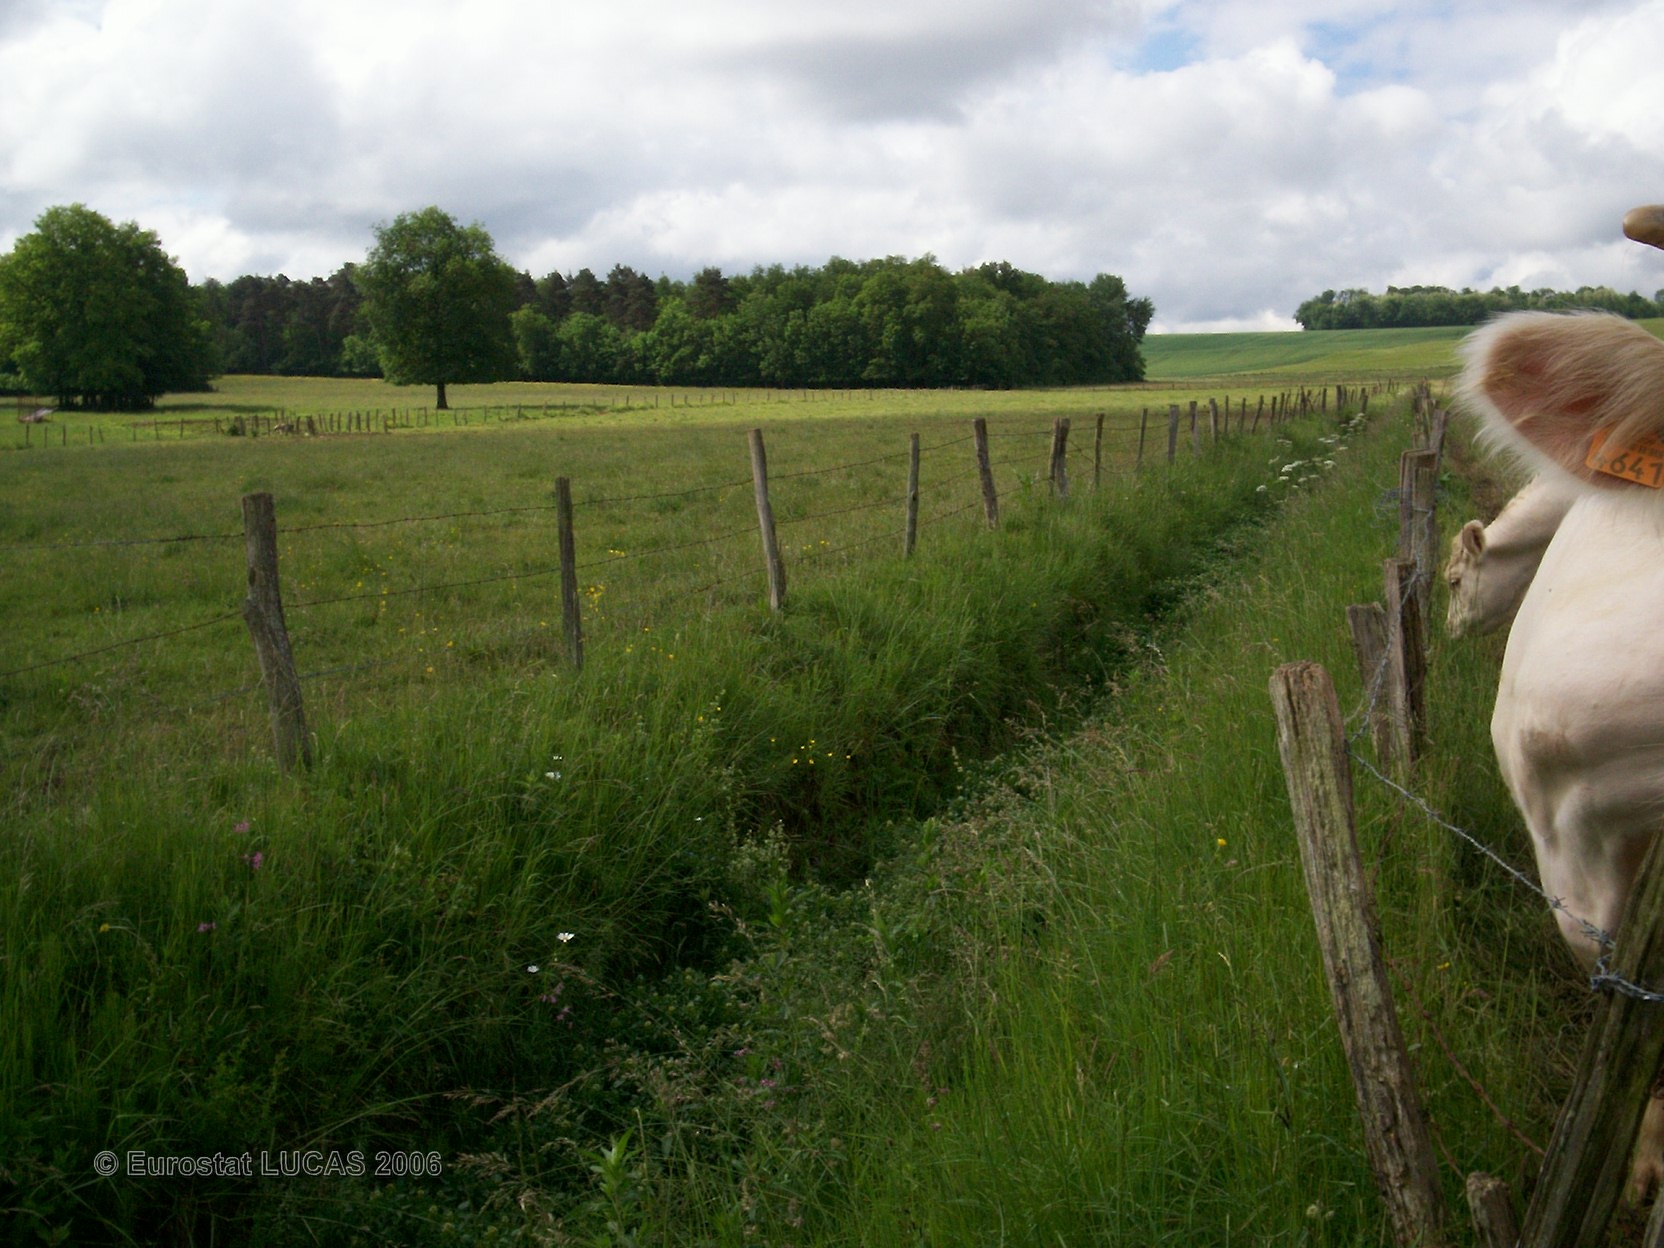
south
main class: Grassland
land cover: Grassland without tree/shrub cover
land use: Agriculture (excluding fallow land and kitchen gardens)
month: May
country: FR
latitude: 48.3046
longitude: 4.5374
